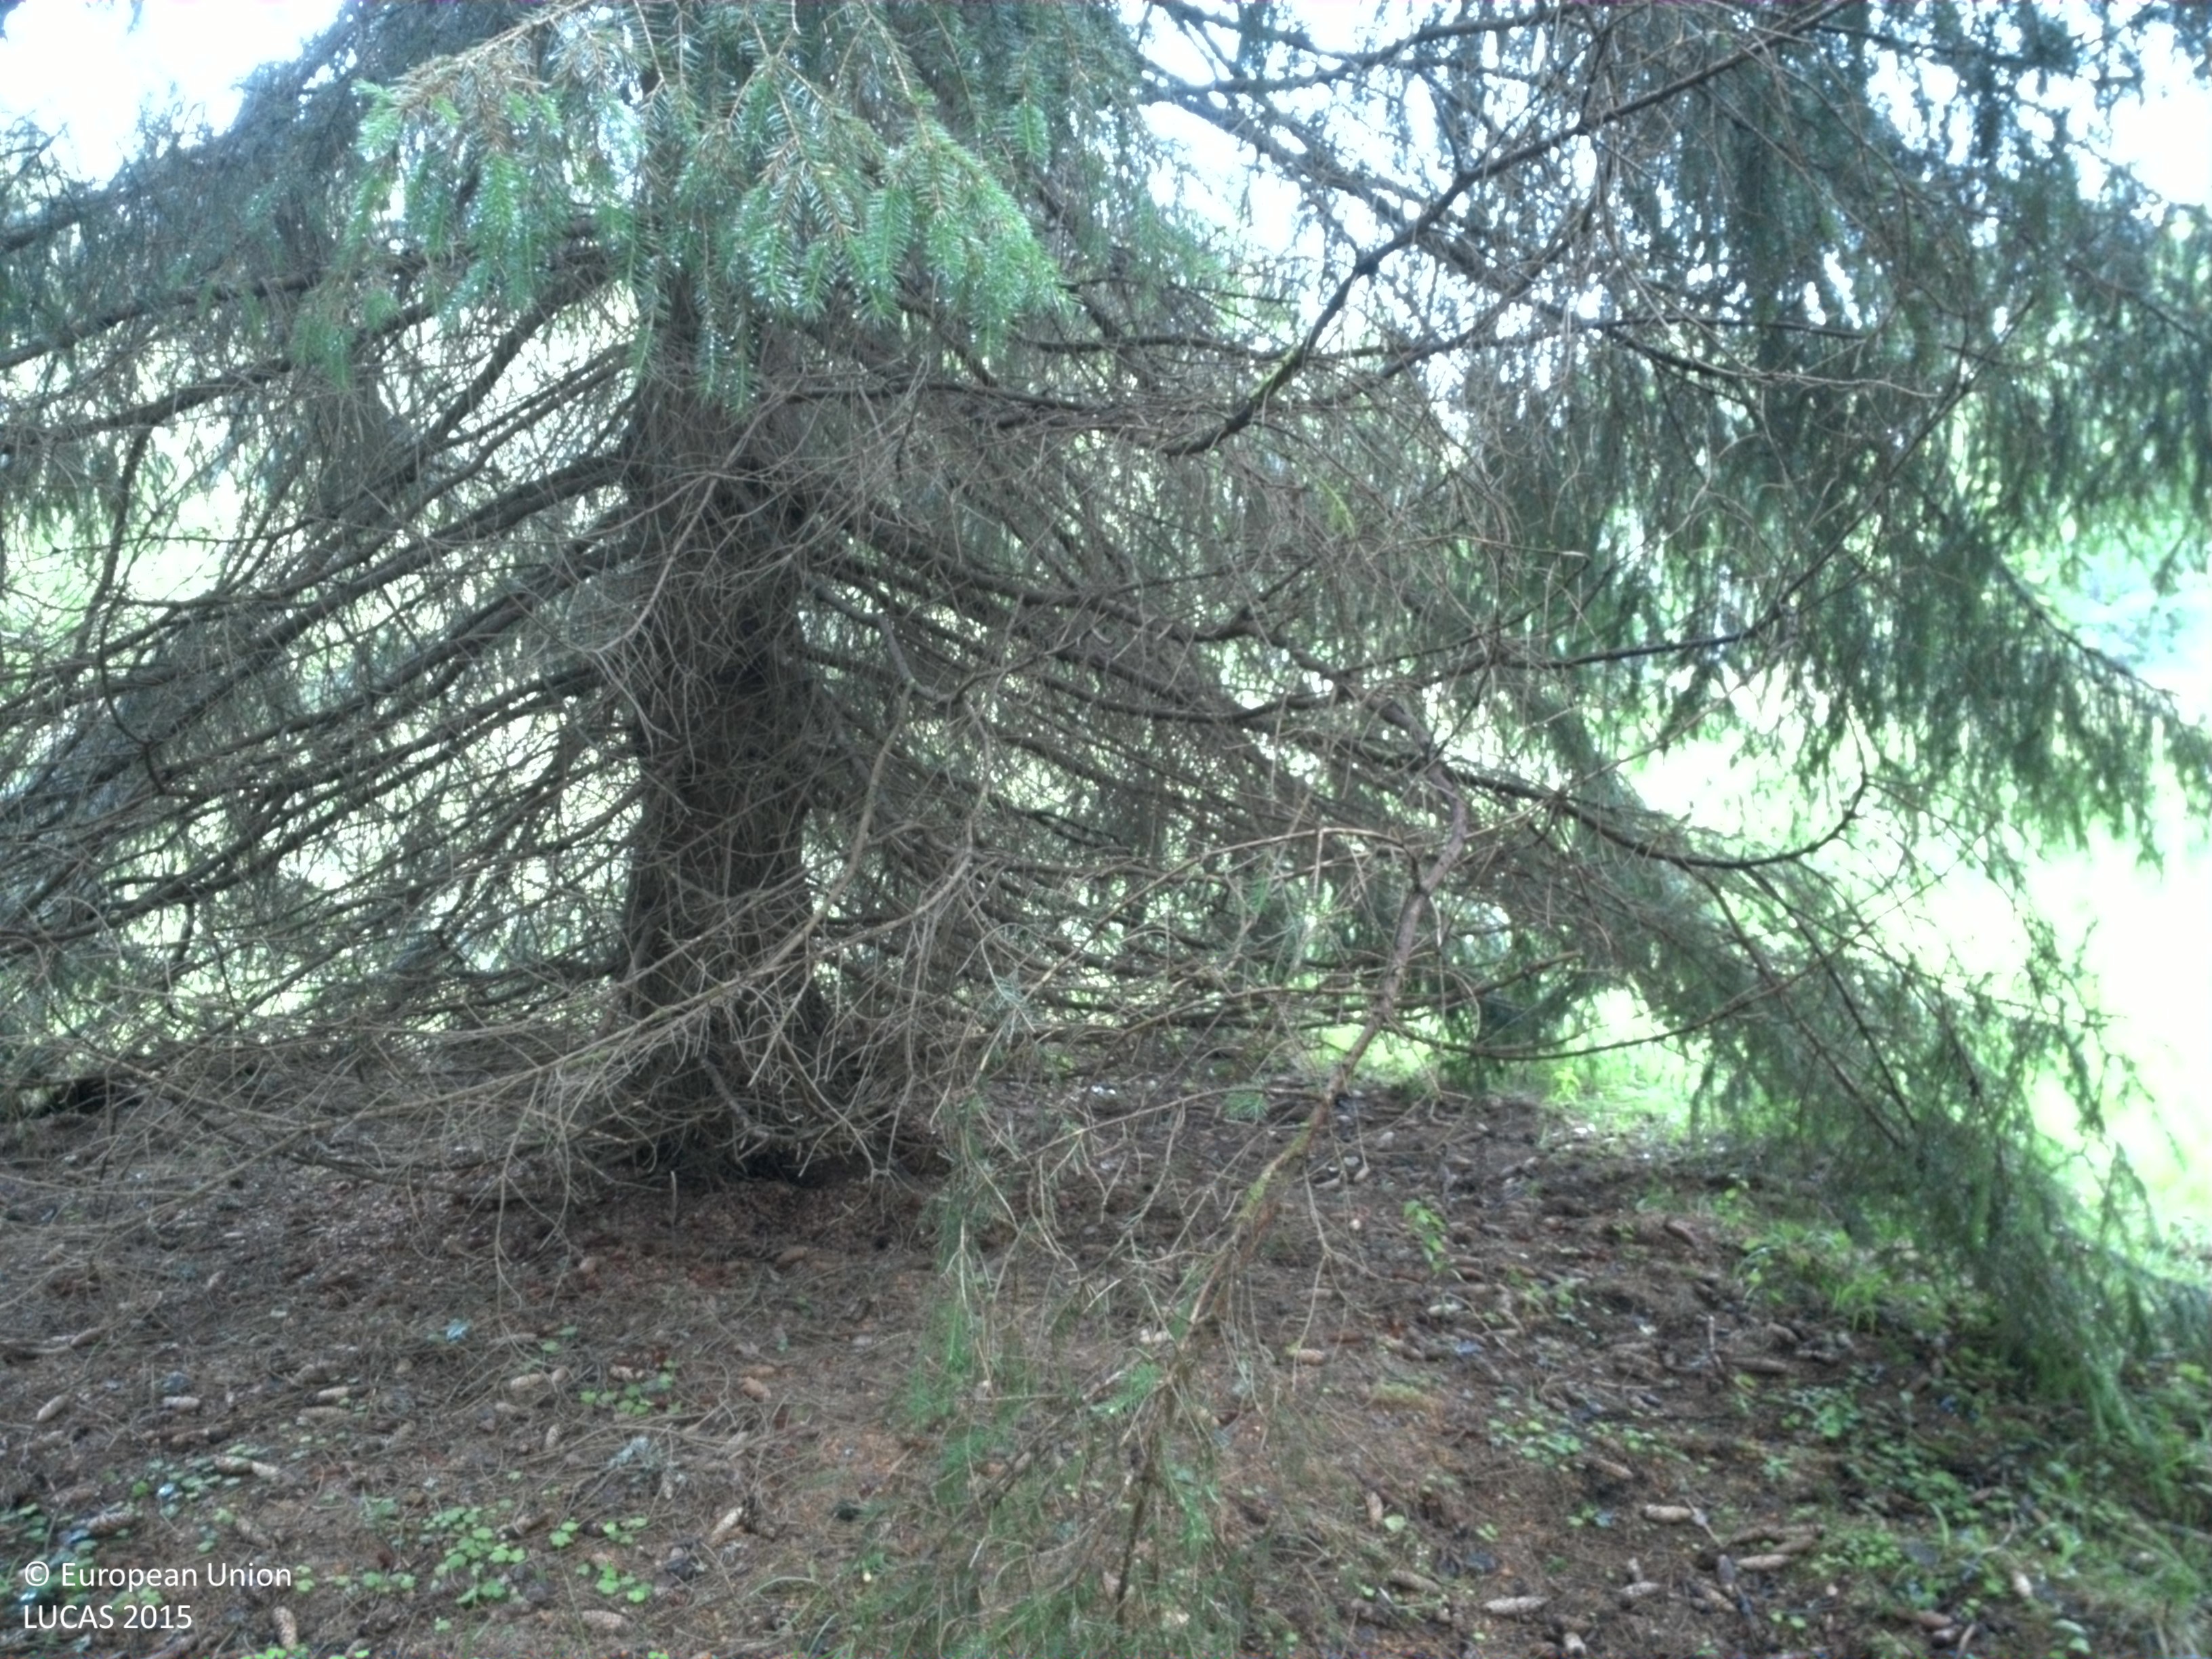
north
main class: Woodland
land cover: Spruce dominated mixed woodland
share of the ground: 50 - 75 %
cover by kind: coniferous forest trees 40 %, herbaceous plants 30 %, broadleaved forest trees 20 %, lichens and mosses 10 %
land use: Forestry
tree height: > 5 m
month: June
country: SE
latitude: 58.5848
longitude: 15.7220
